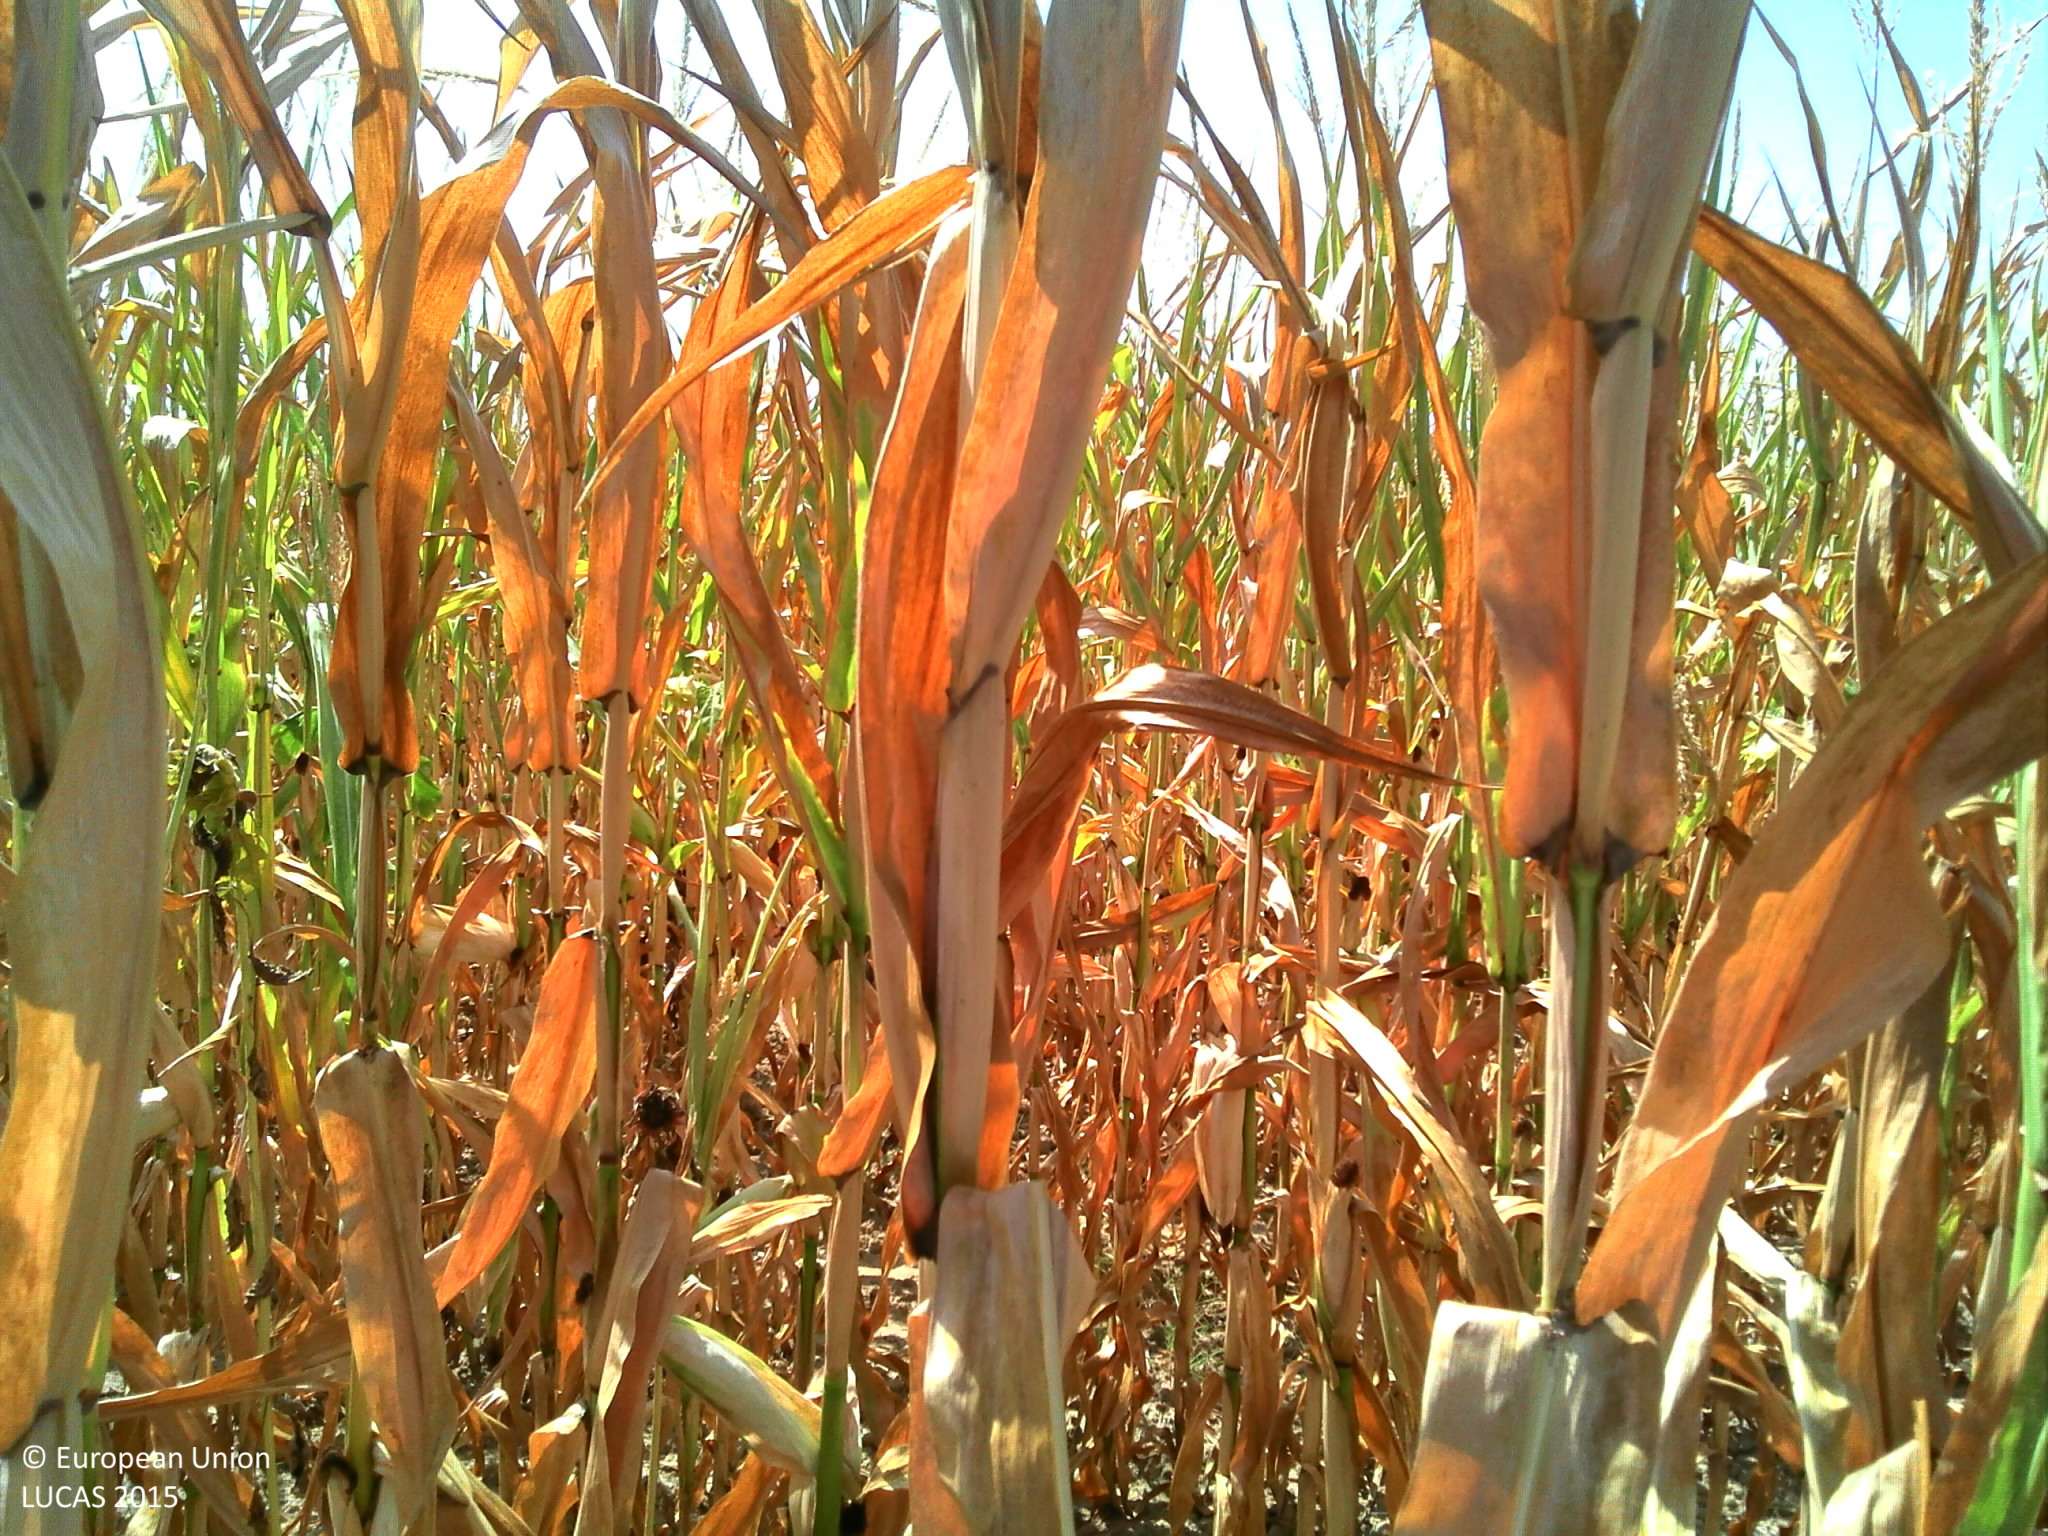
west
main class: Grassland
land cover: Grassland with sparse tree/shrub cover
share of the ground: > 75 %
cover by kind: herbaceous plants 90 %, broadleaved forest trees 5 %, shrubs 5 %
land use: Residential
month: August
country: FR
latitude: 44.1661
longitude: 0.6784
